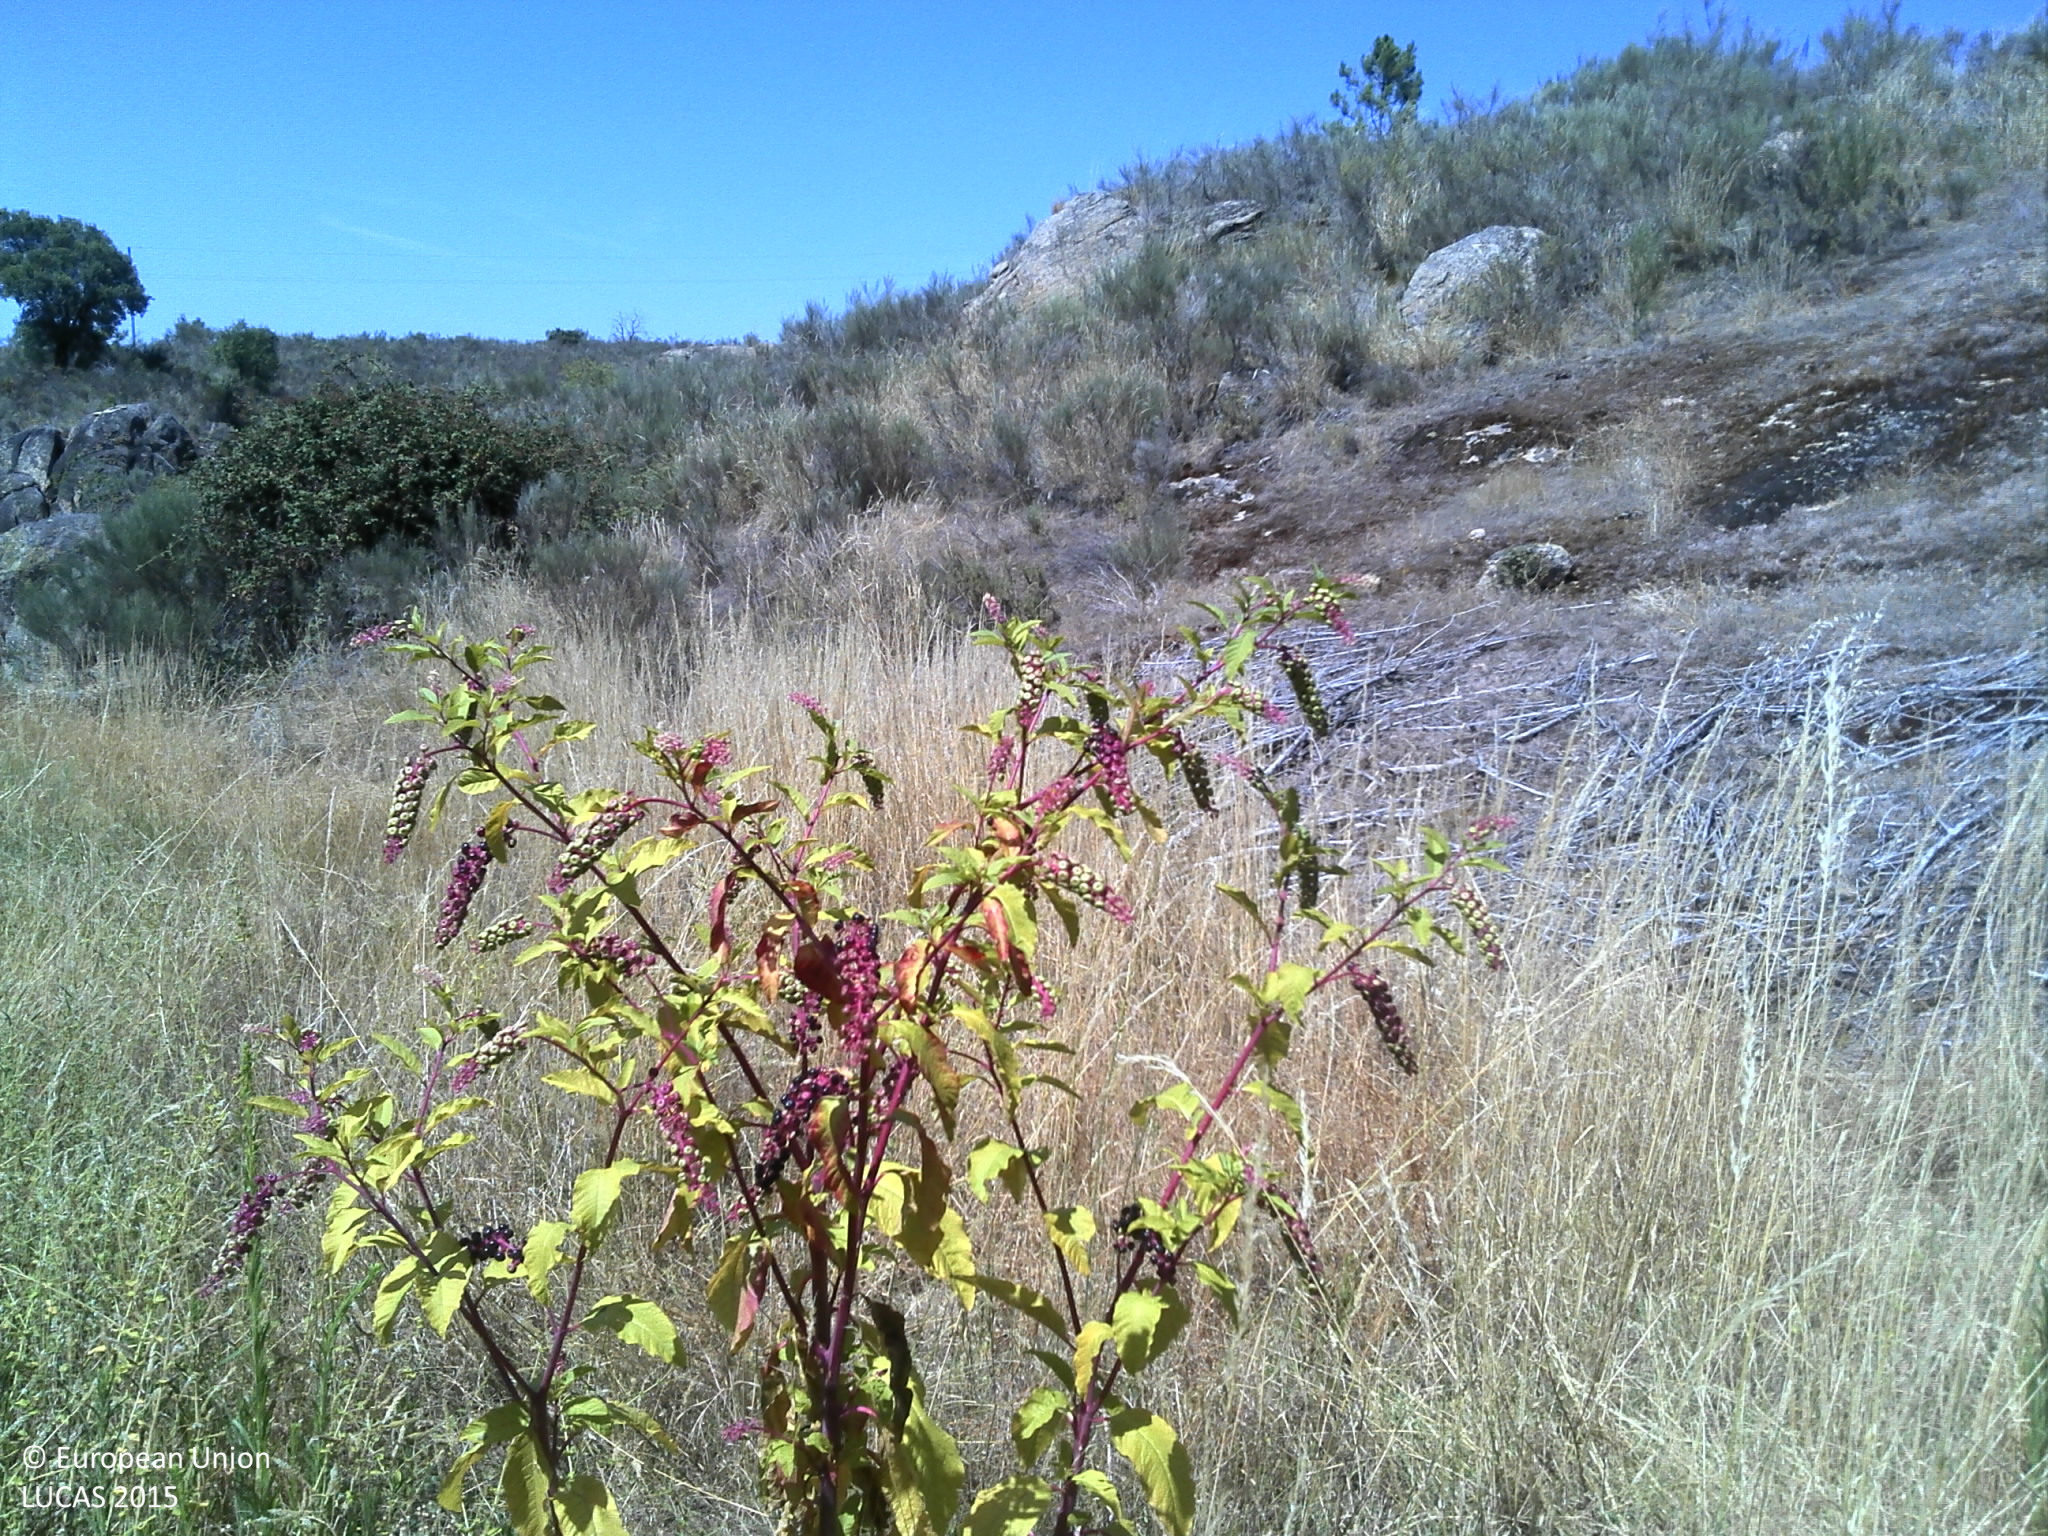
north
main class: Grassland
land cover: Grassland without tree/shrub cover
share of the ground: > 75 %
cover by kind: herbaceous plants 100 %
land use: Agriculture (excluding fallow land and kitchen gardens)
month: July
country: PT
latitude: 41.3121
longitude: -7.3327
